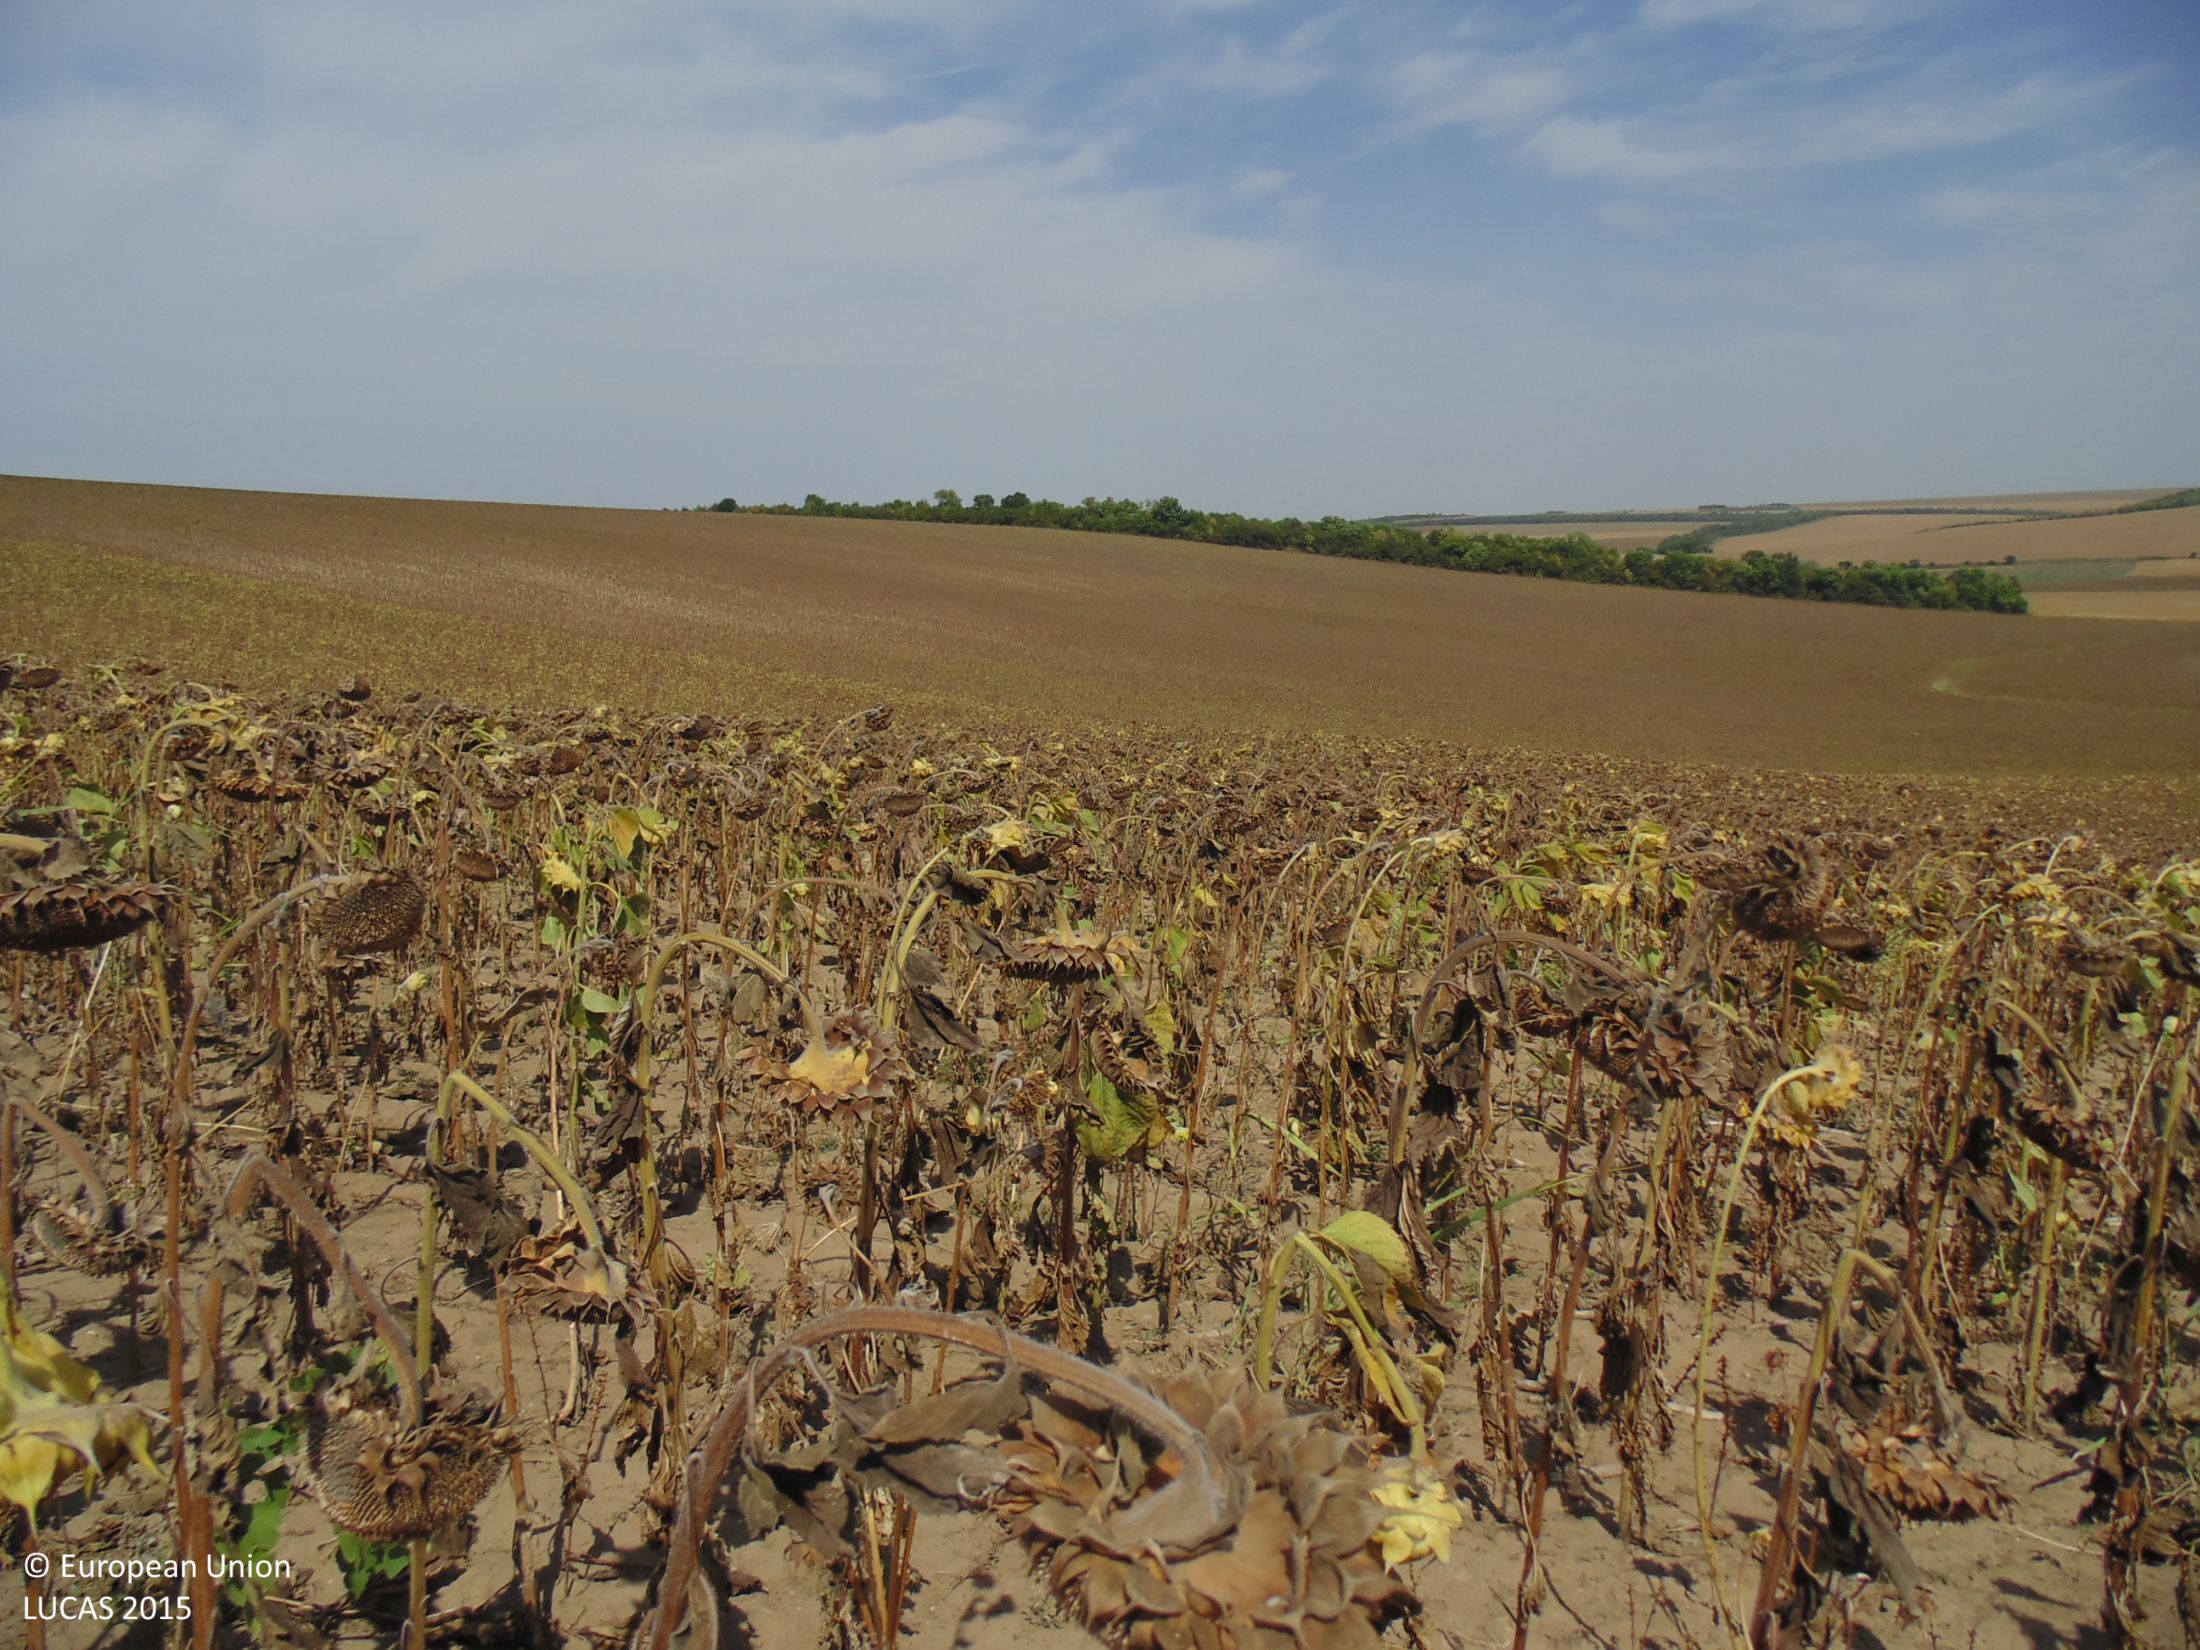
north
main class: Cropland
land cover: Sunflower
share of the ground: > 75 %
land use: Agriculture (excluding fallow land and kitchen gardens)
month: September
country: BG
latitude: 44.0093
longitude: 27.1786
